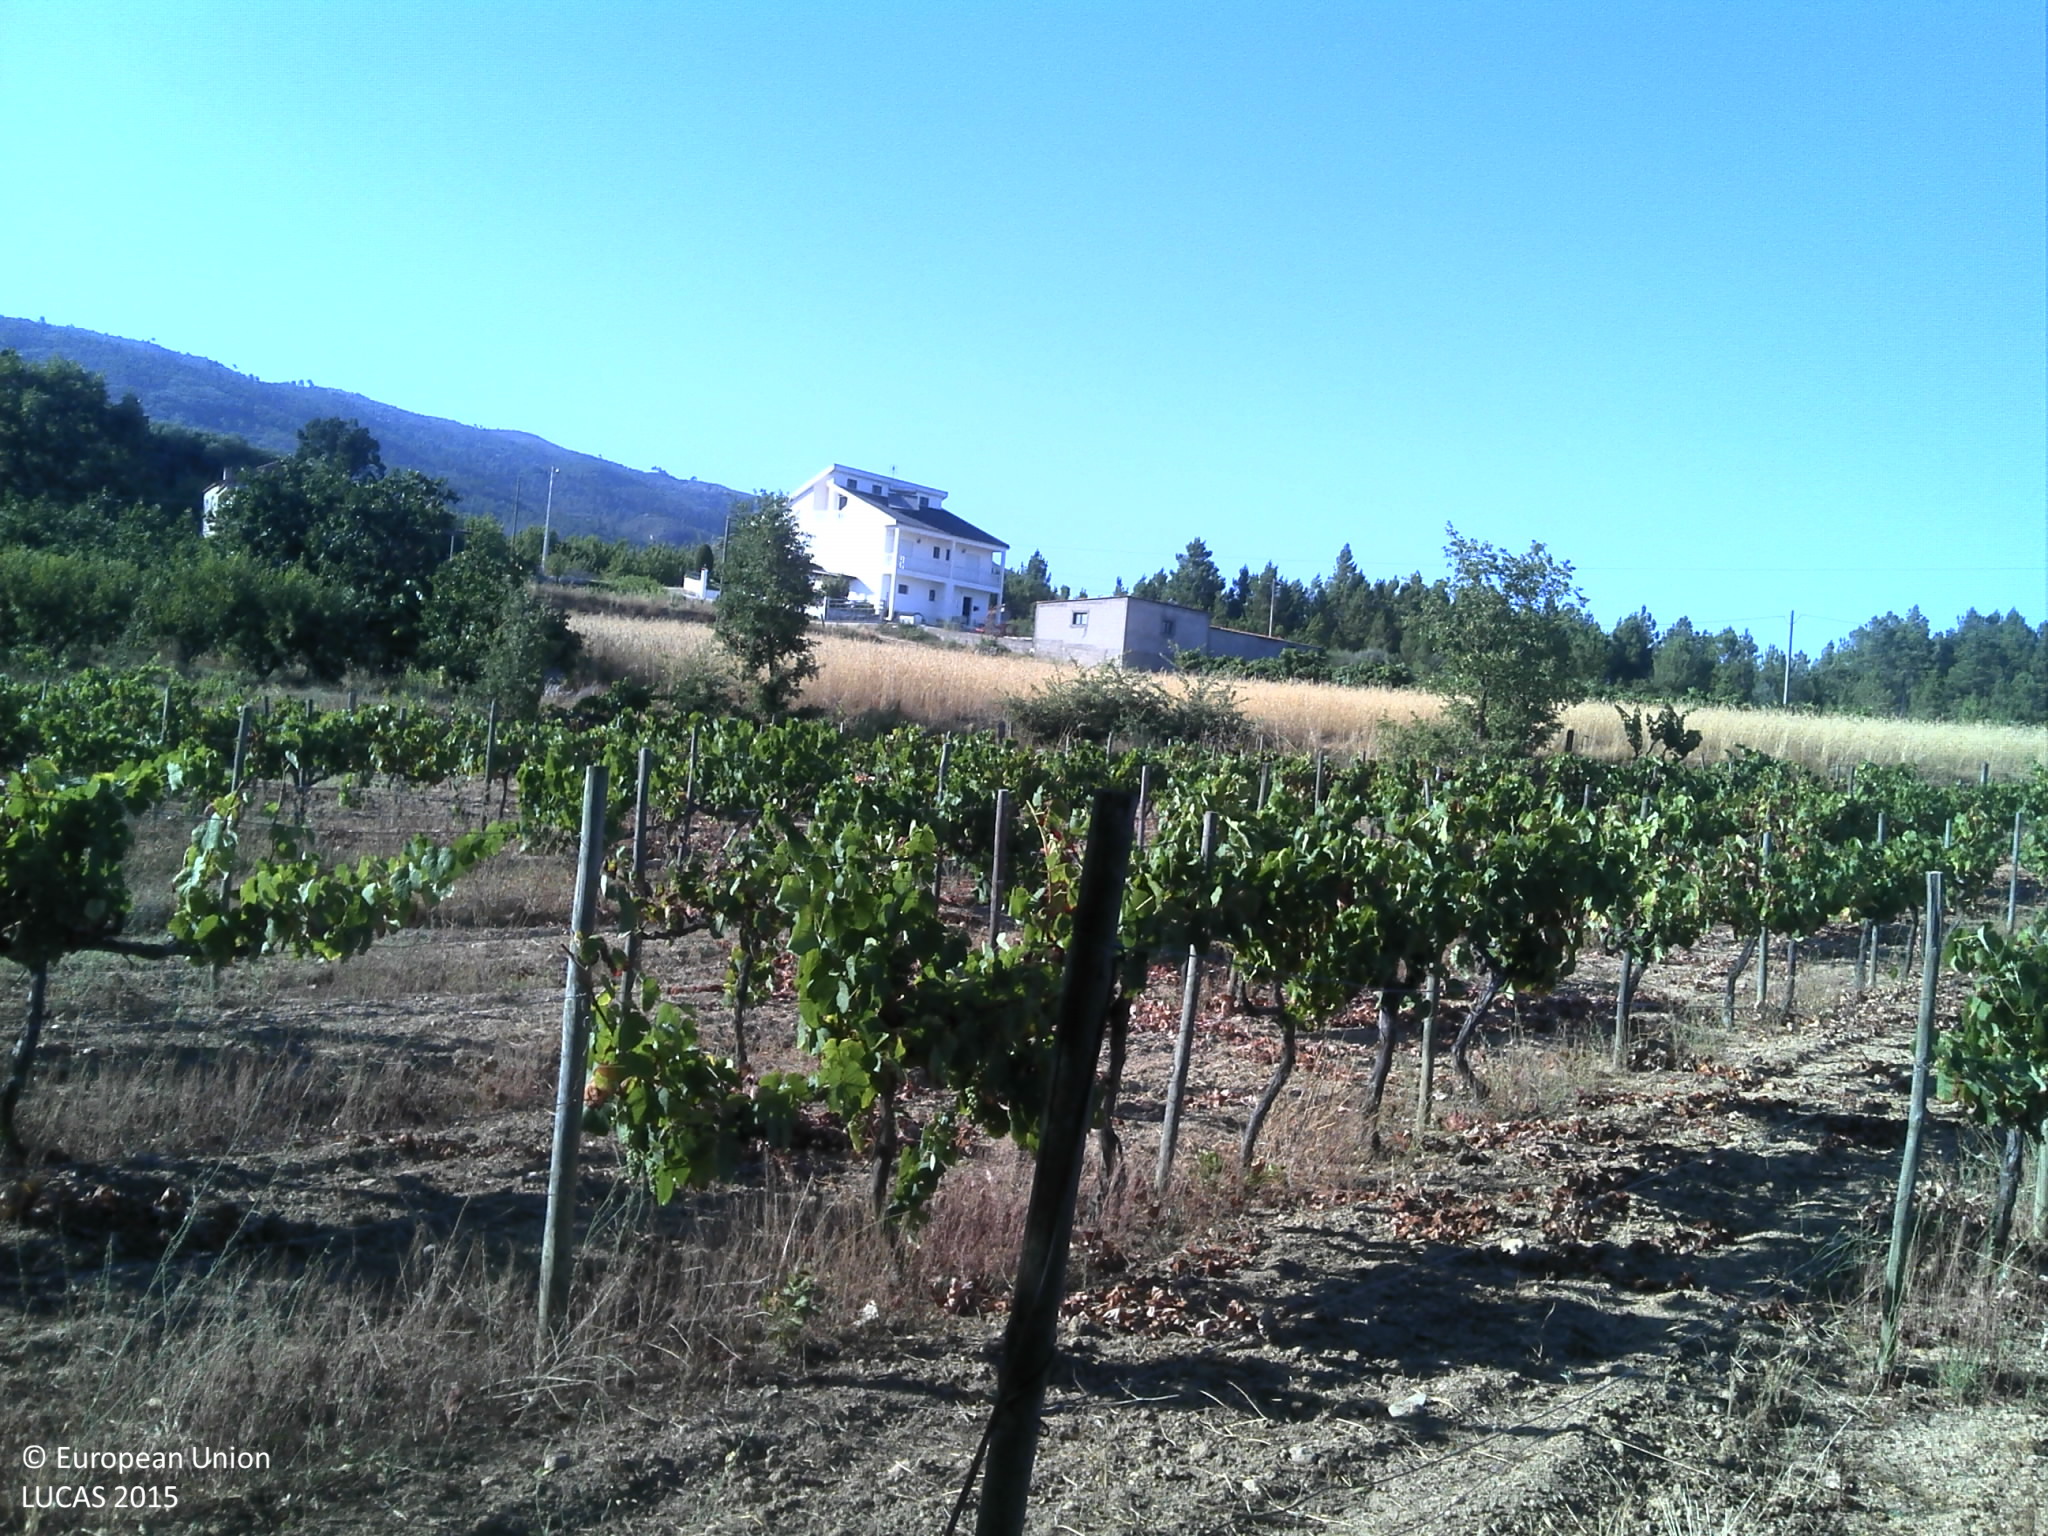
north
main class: Cropland
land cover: Vineyards
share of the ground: 10 - 25 %
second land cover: Other bare soil
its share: > 75 %
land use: Agriculture (excluding fallow land and kitchen gardens)
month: July
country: PT
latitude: 40.3198
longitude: -7.4171
